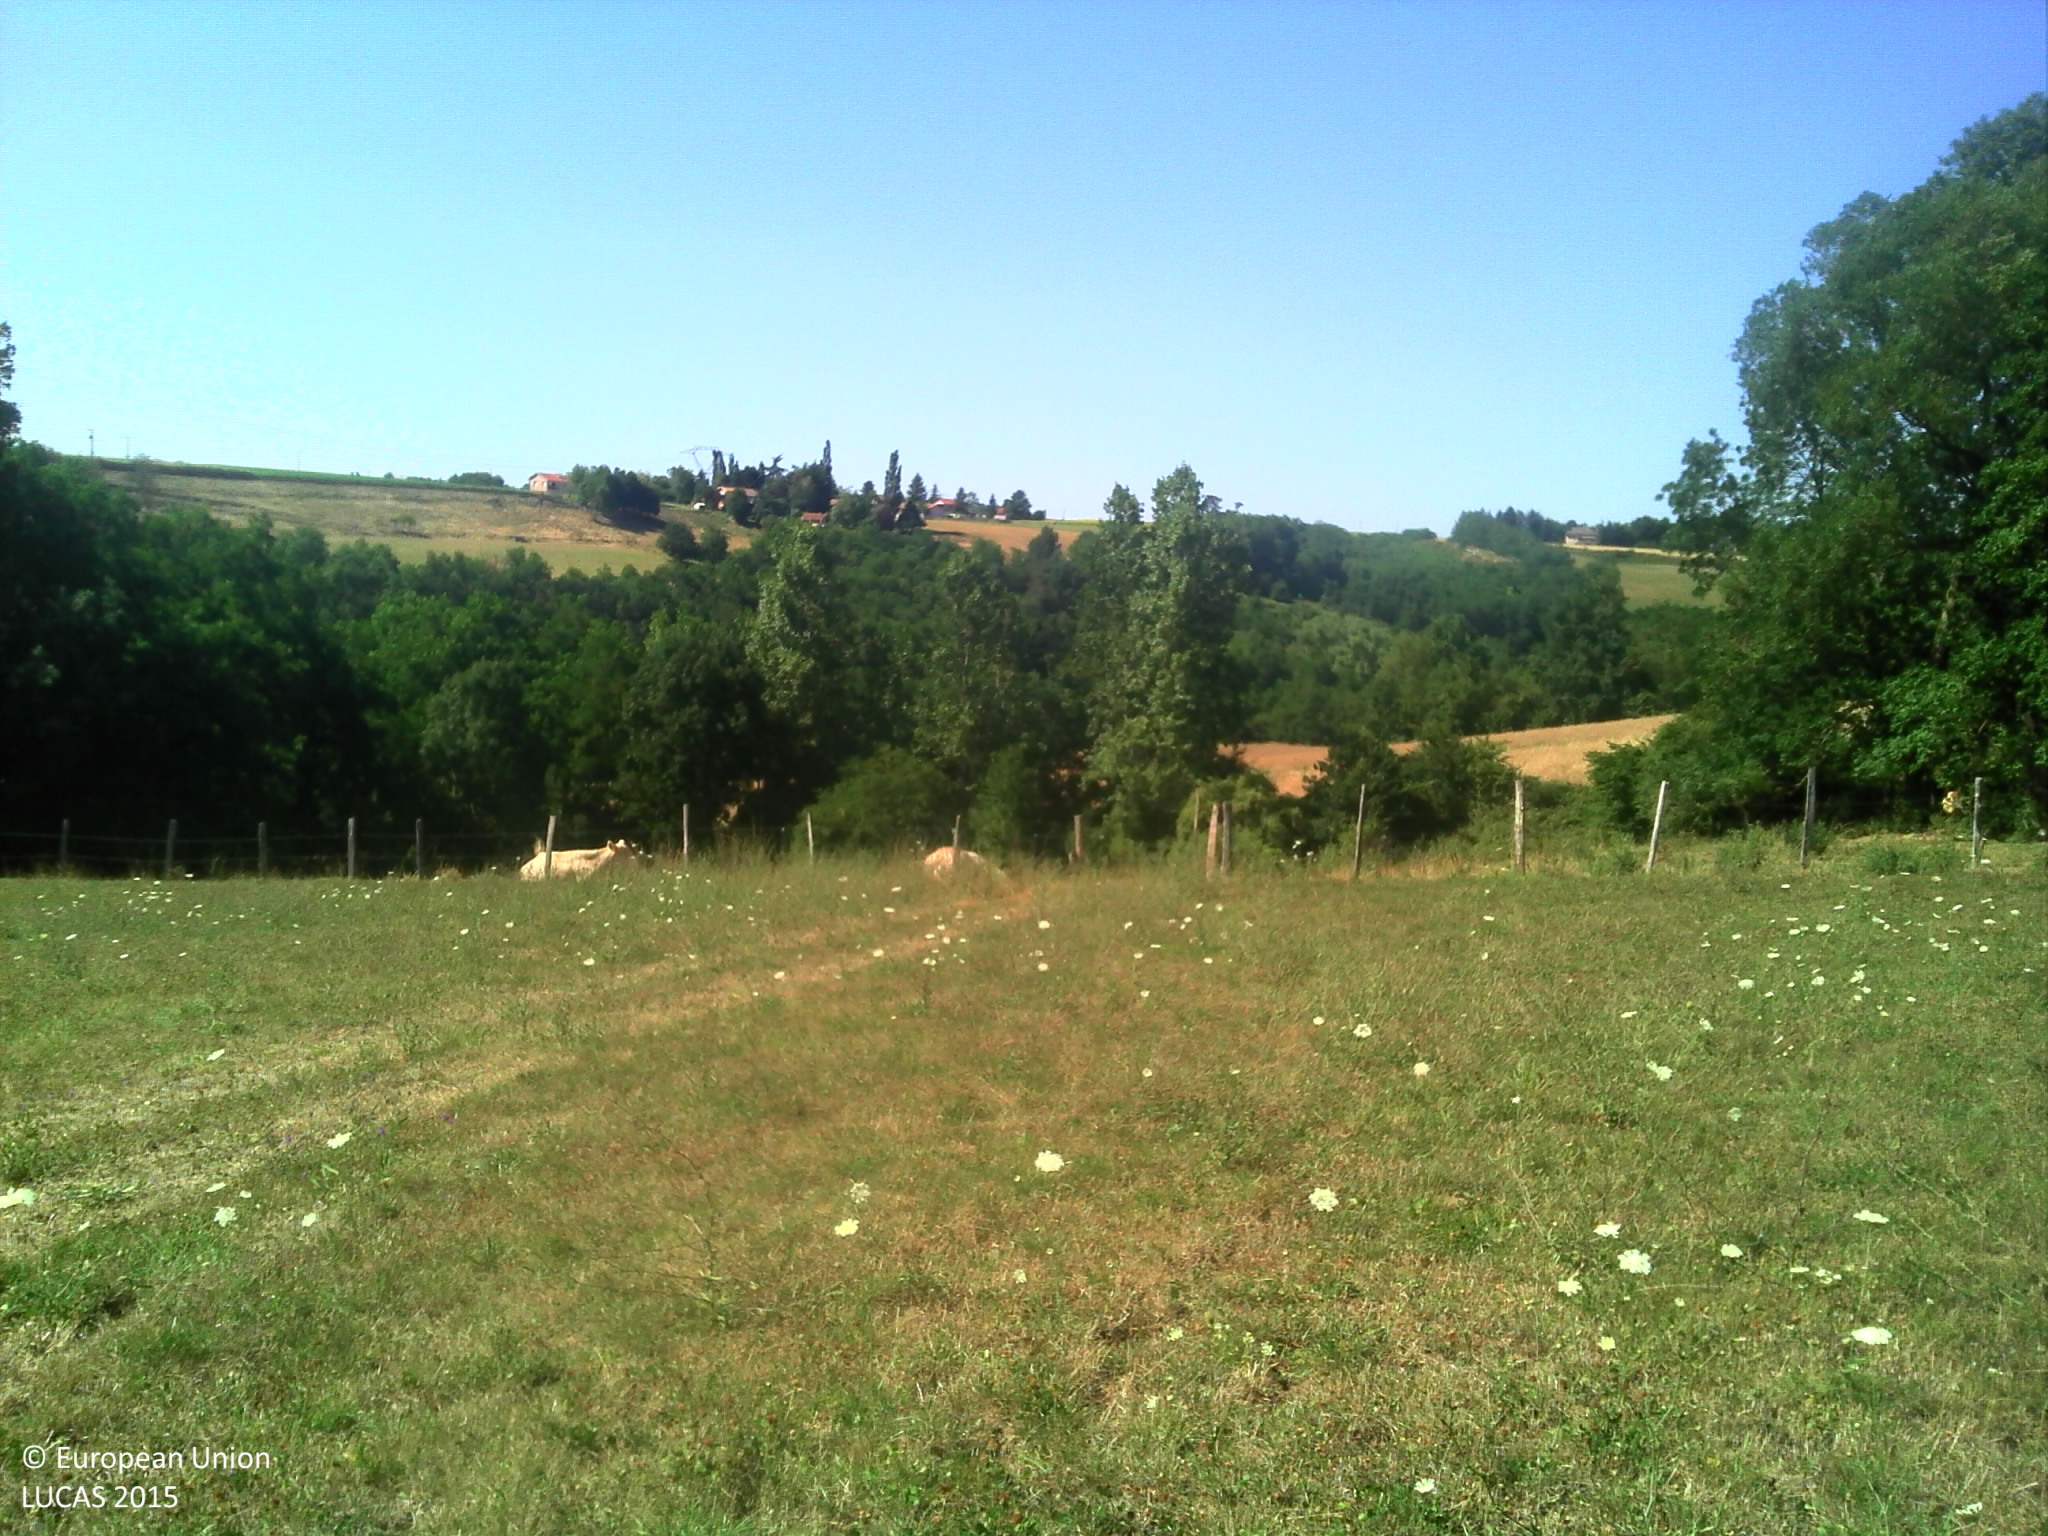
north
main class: Grassland
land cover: Grassland without tree/shrub cover
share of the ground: > 75 %
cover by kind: herbaceous plants 100 %
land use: Agriculture (excluding fallow land and kitchen gardens)
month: July
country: FR
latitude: 45.6010
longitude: 4.9656
